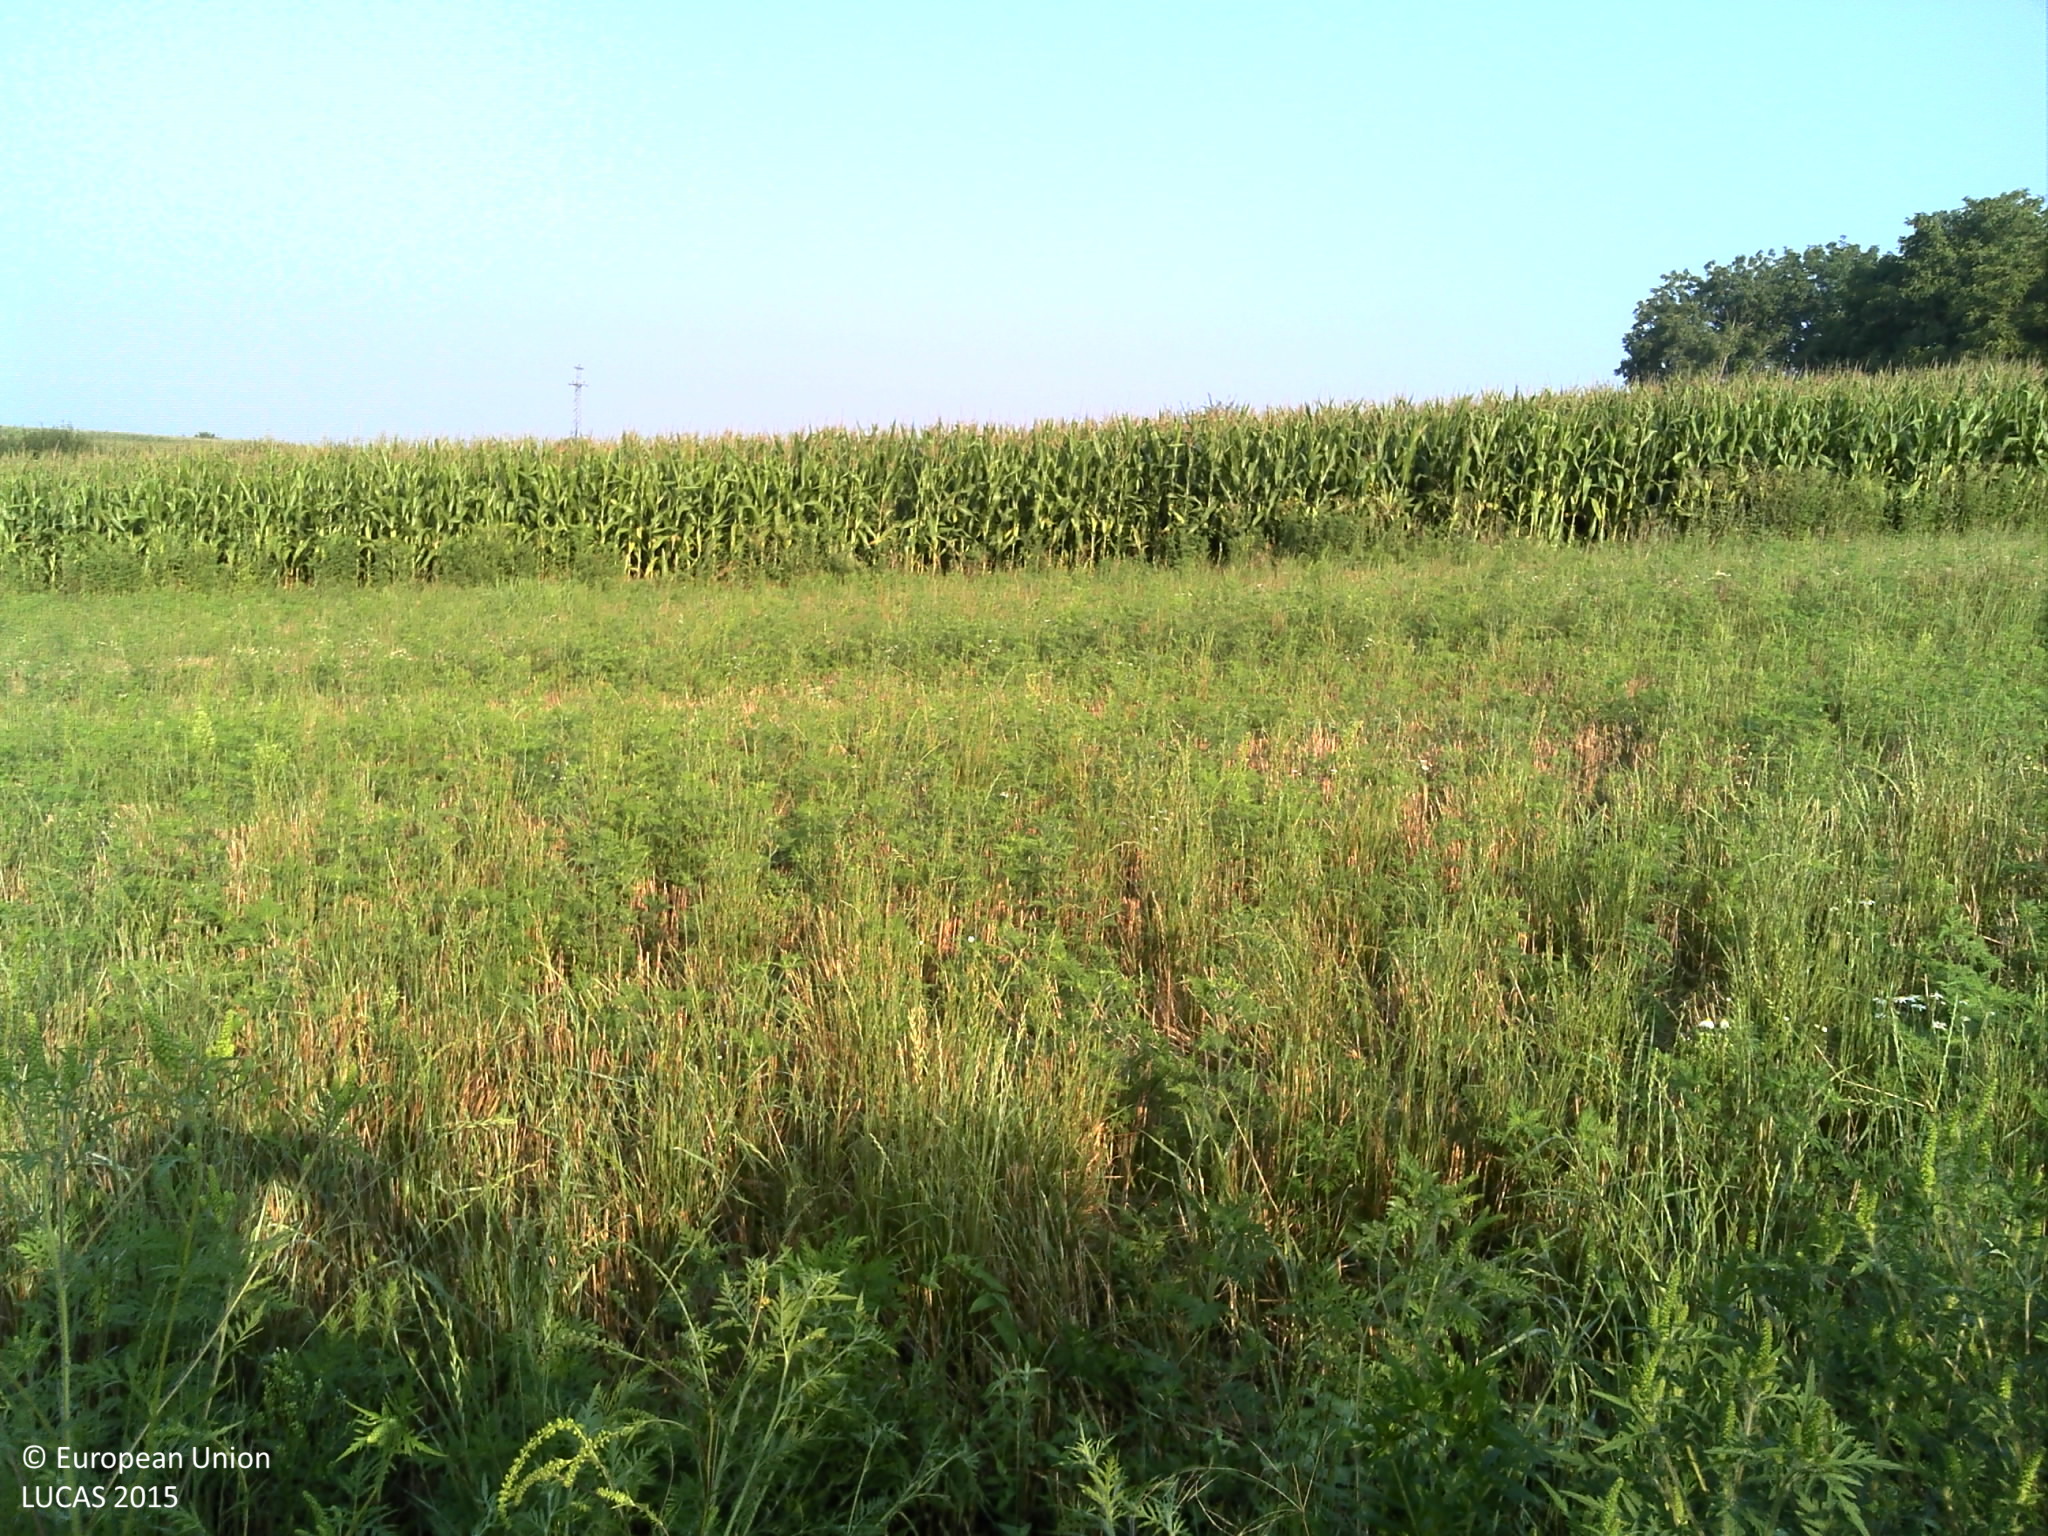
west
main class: Cropland
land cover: Maize
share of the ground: > 75 %
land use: Agriculture (excluding fallow land and kitchen gardens)
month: August
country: HR
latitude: 45.6690
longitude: 17.2793
